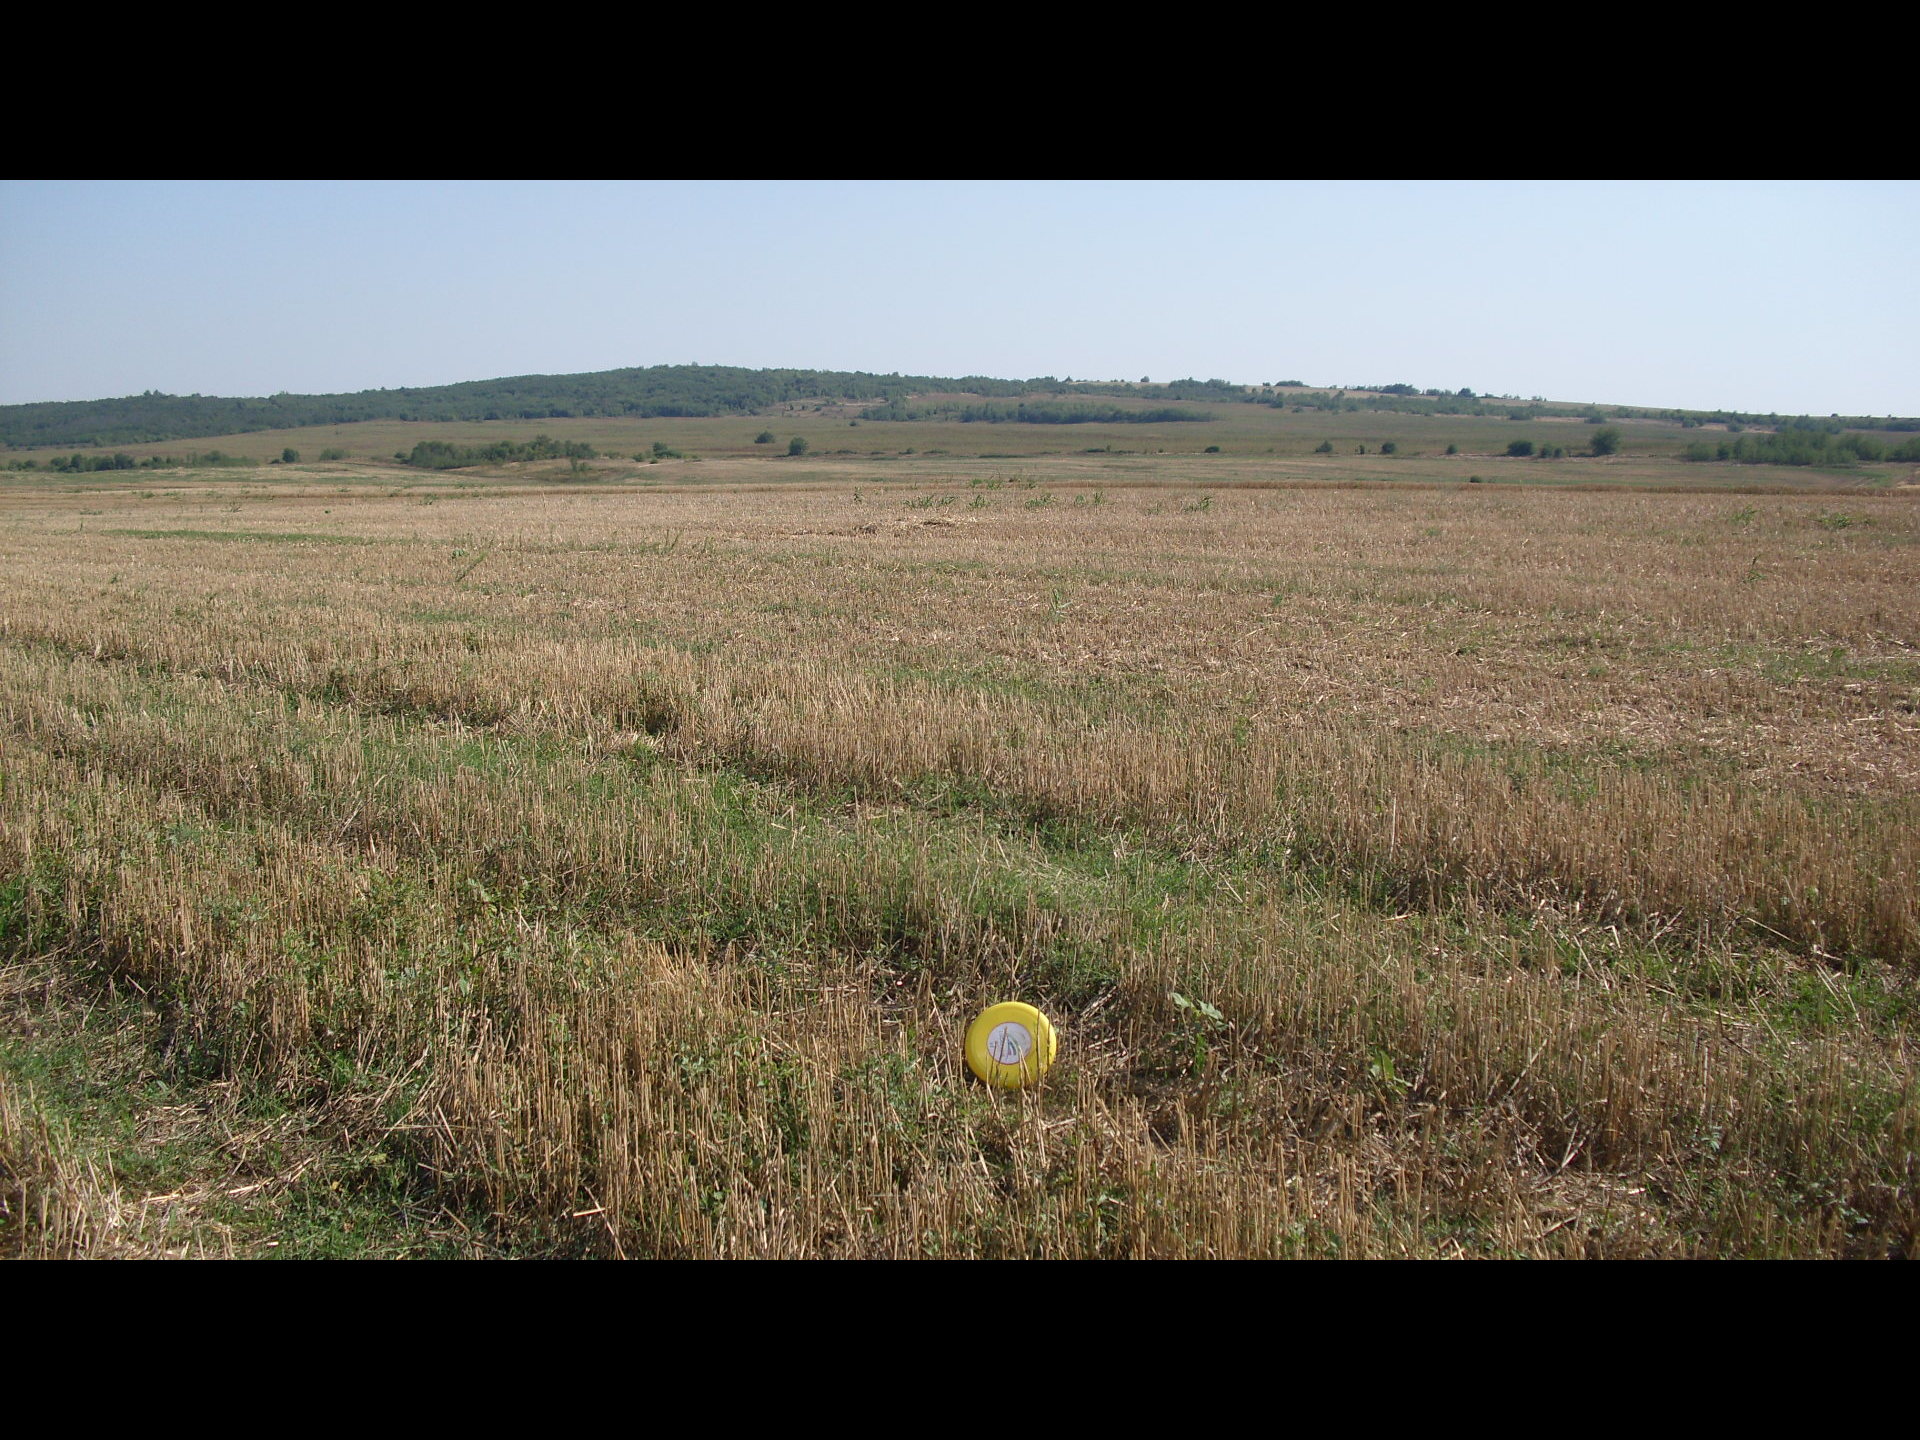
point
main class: Cropland
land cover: Common wheat
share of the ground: 50 - 75 %
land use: Agriculture (excluding fallow land and kitchen gardens)
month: August
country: BG
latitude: 44.1500
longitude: 22.7034
